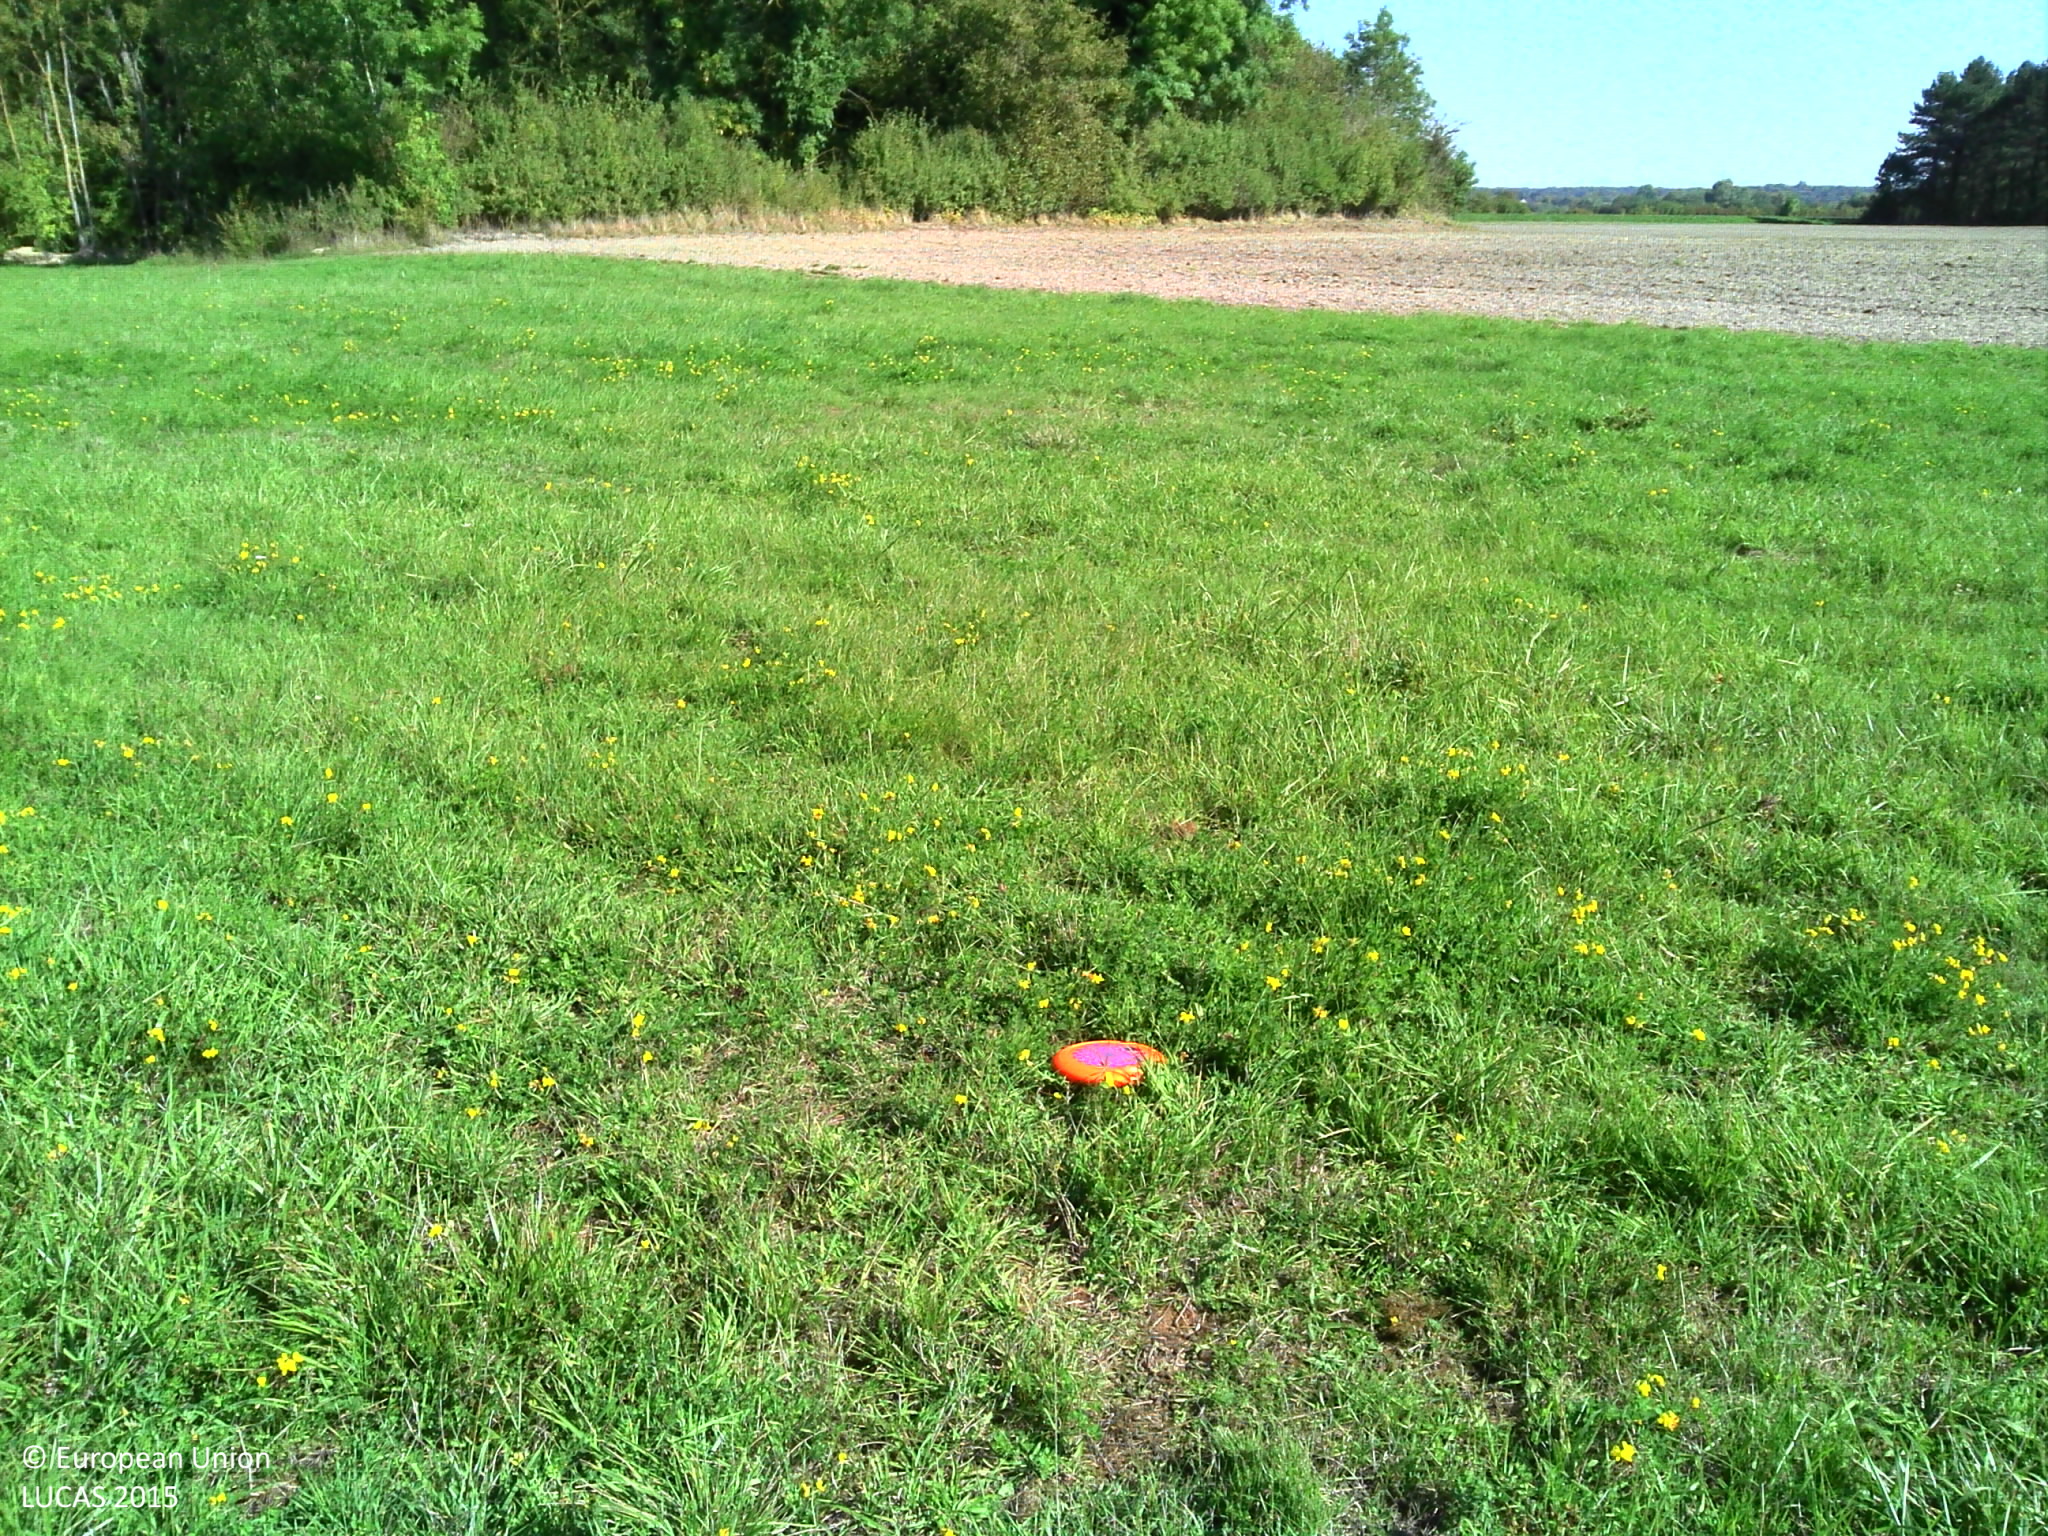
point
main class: Cropland
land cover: Temporary grasslands
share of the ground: > 75 %
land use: Agriculture (excluding fallow land and kitchen gardens)
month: September
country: FR
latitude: 48.1791
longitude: 4.2004
